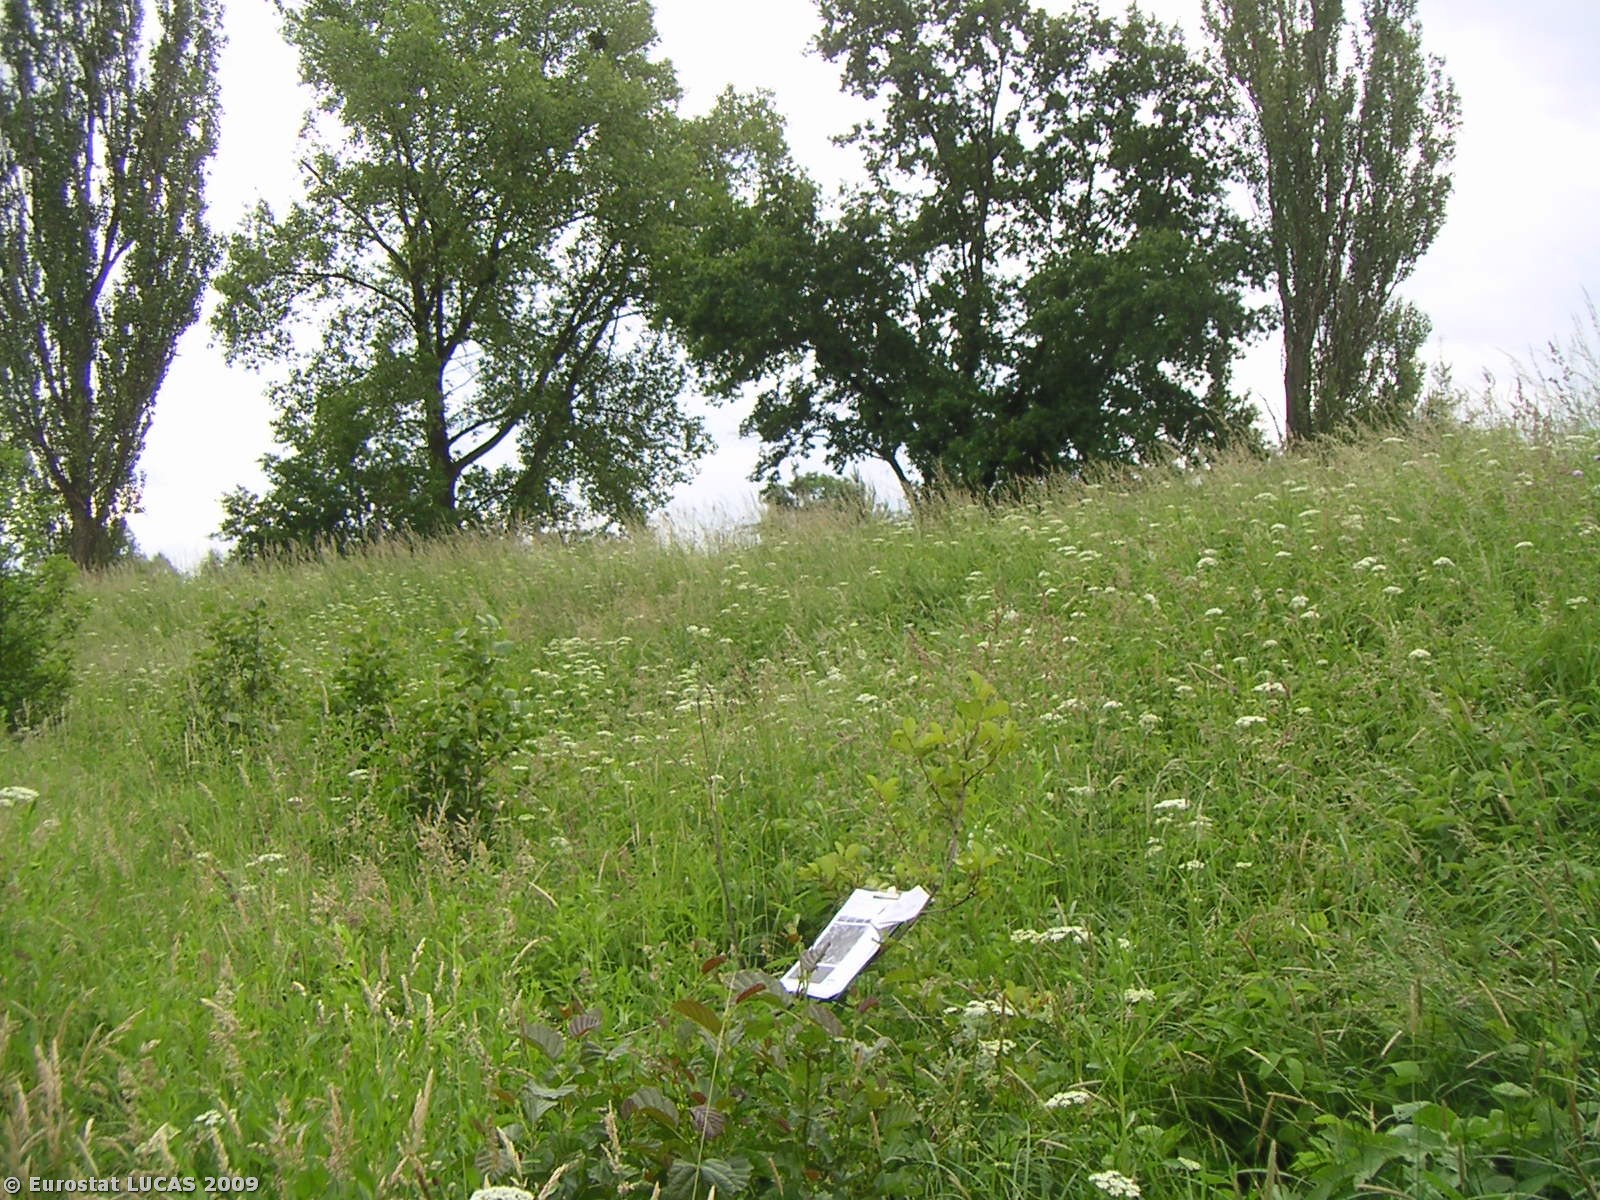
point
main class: Grassland
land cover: Grassland with sparse tree/shrub cover
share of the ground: > 75 %
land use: Agriculture (excluding fallow land and kitchen gardens)
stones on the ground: 10 - 25 %
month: June
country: PL
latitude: 49.9016
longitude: 18.7502
